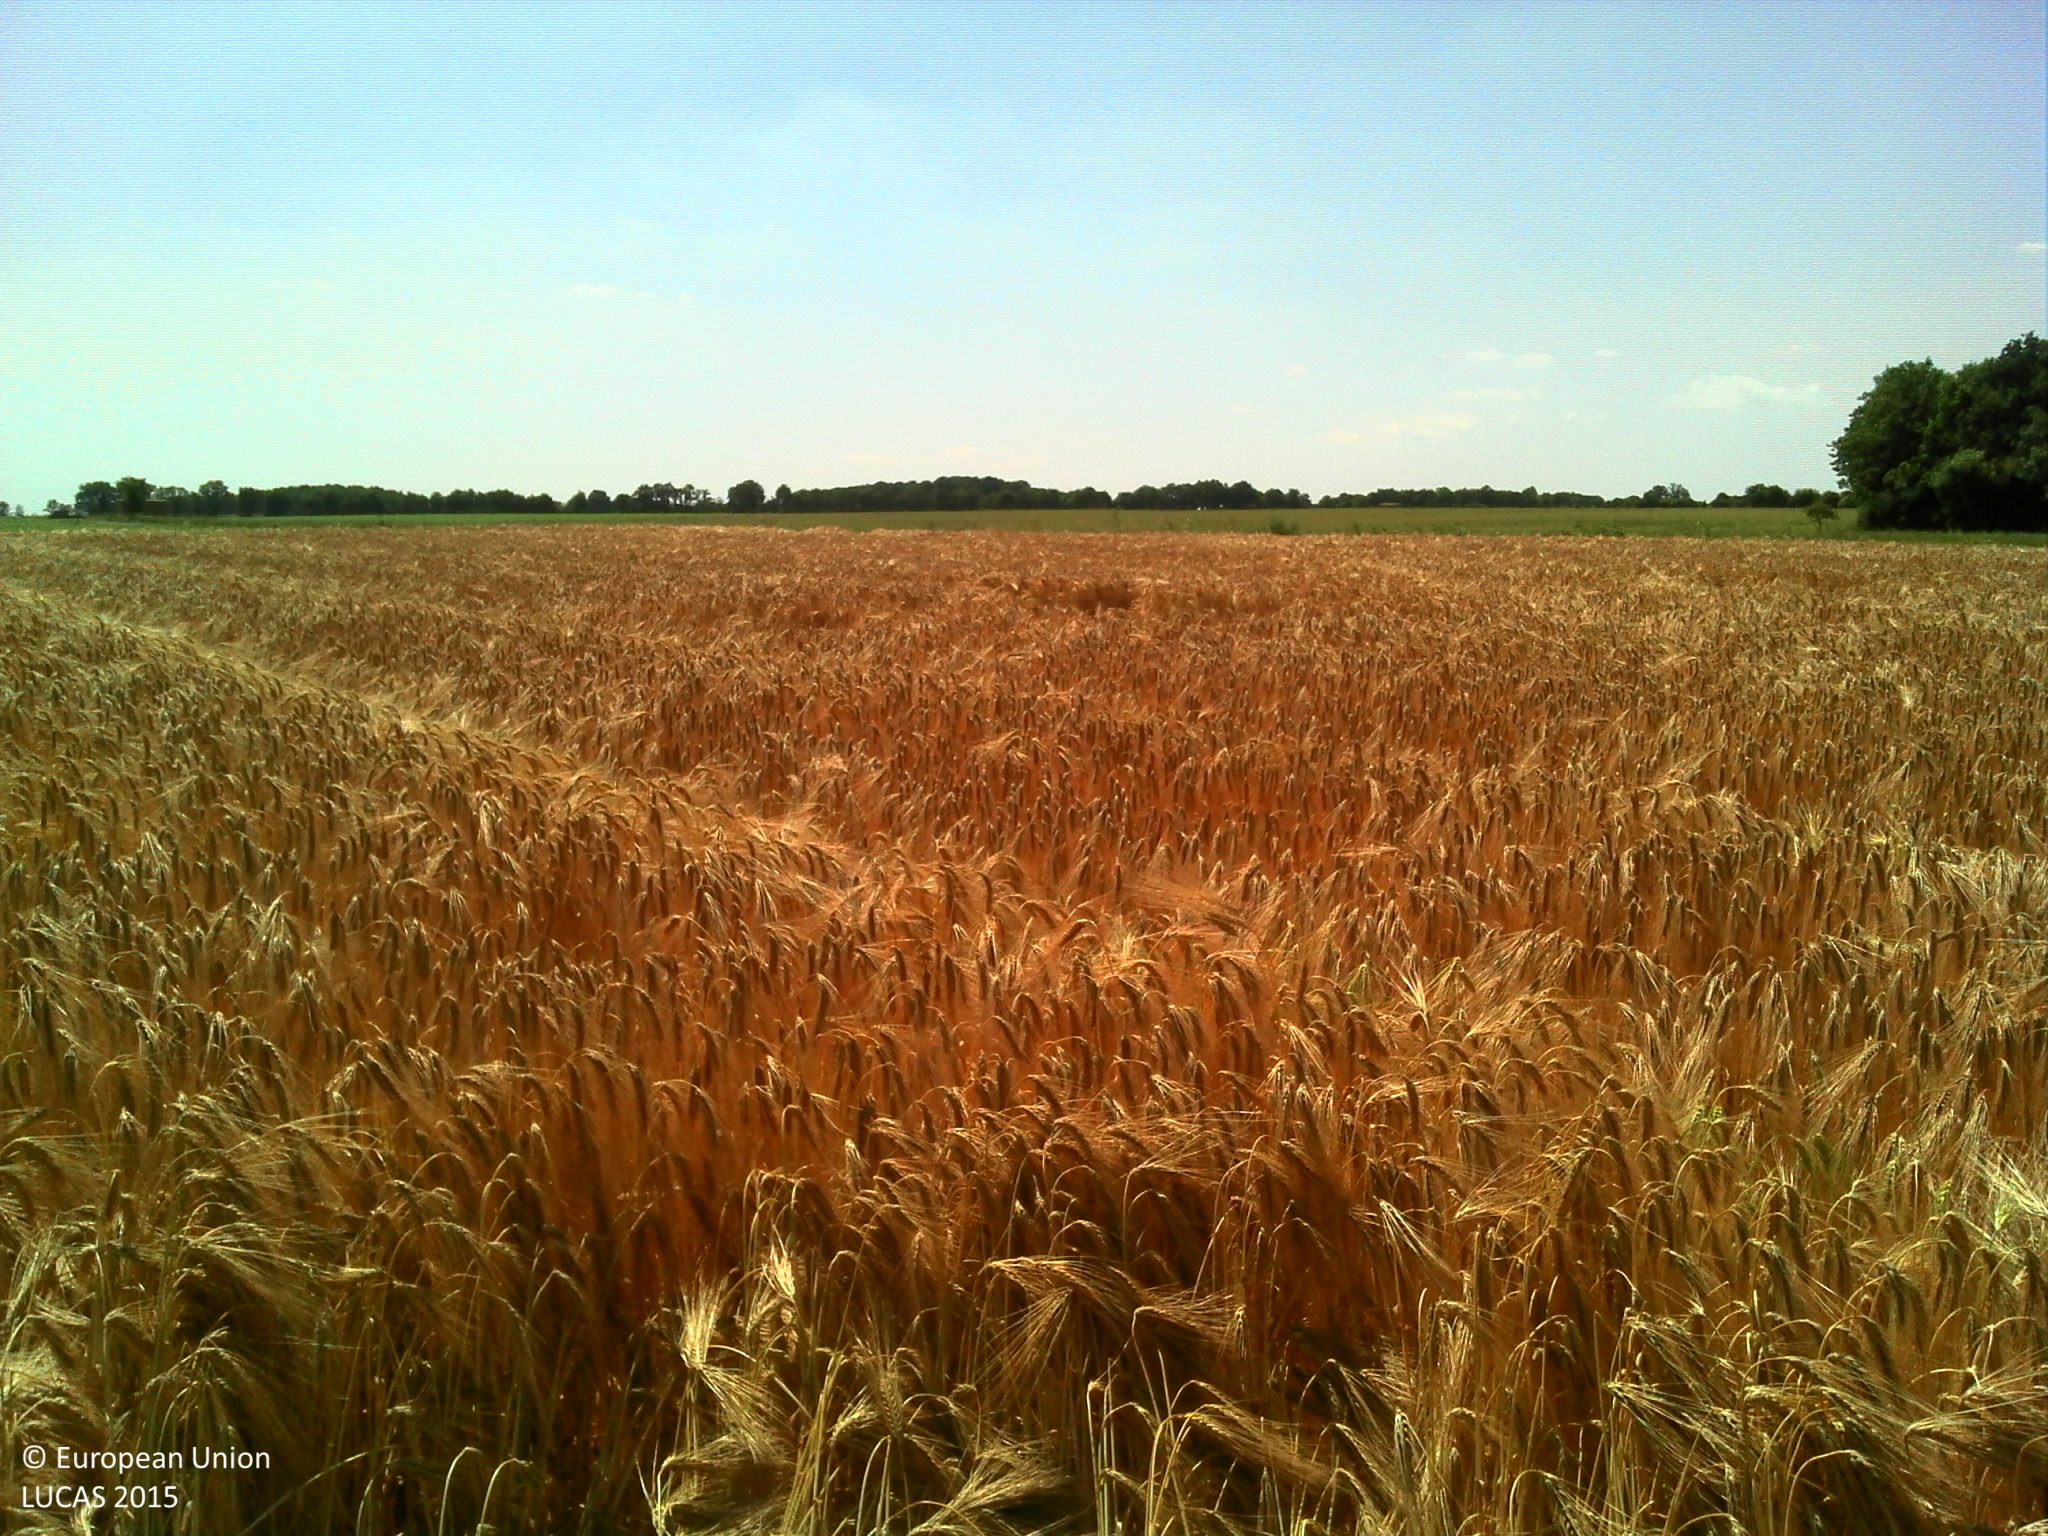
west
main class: Cropland
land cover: Barley
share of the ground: > 75 %
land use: Agriculture (excluding fallow land and kitchen gardens)
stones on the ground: < 10 %
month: June
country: FR
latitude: 46.8504
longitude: -1.3823
